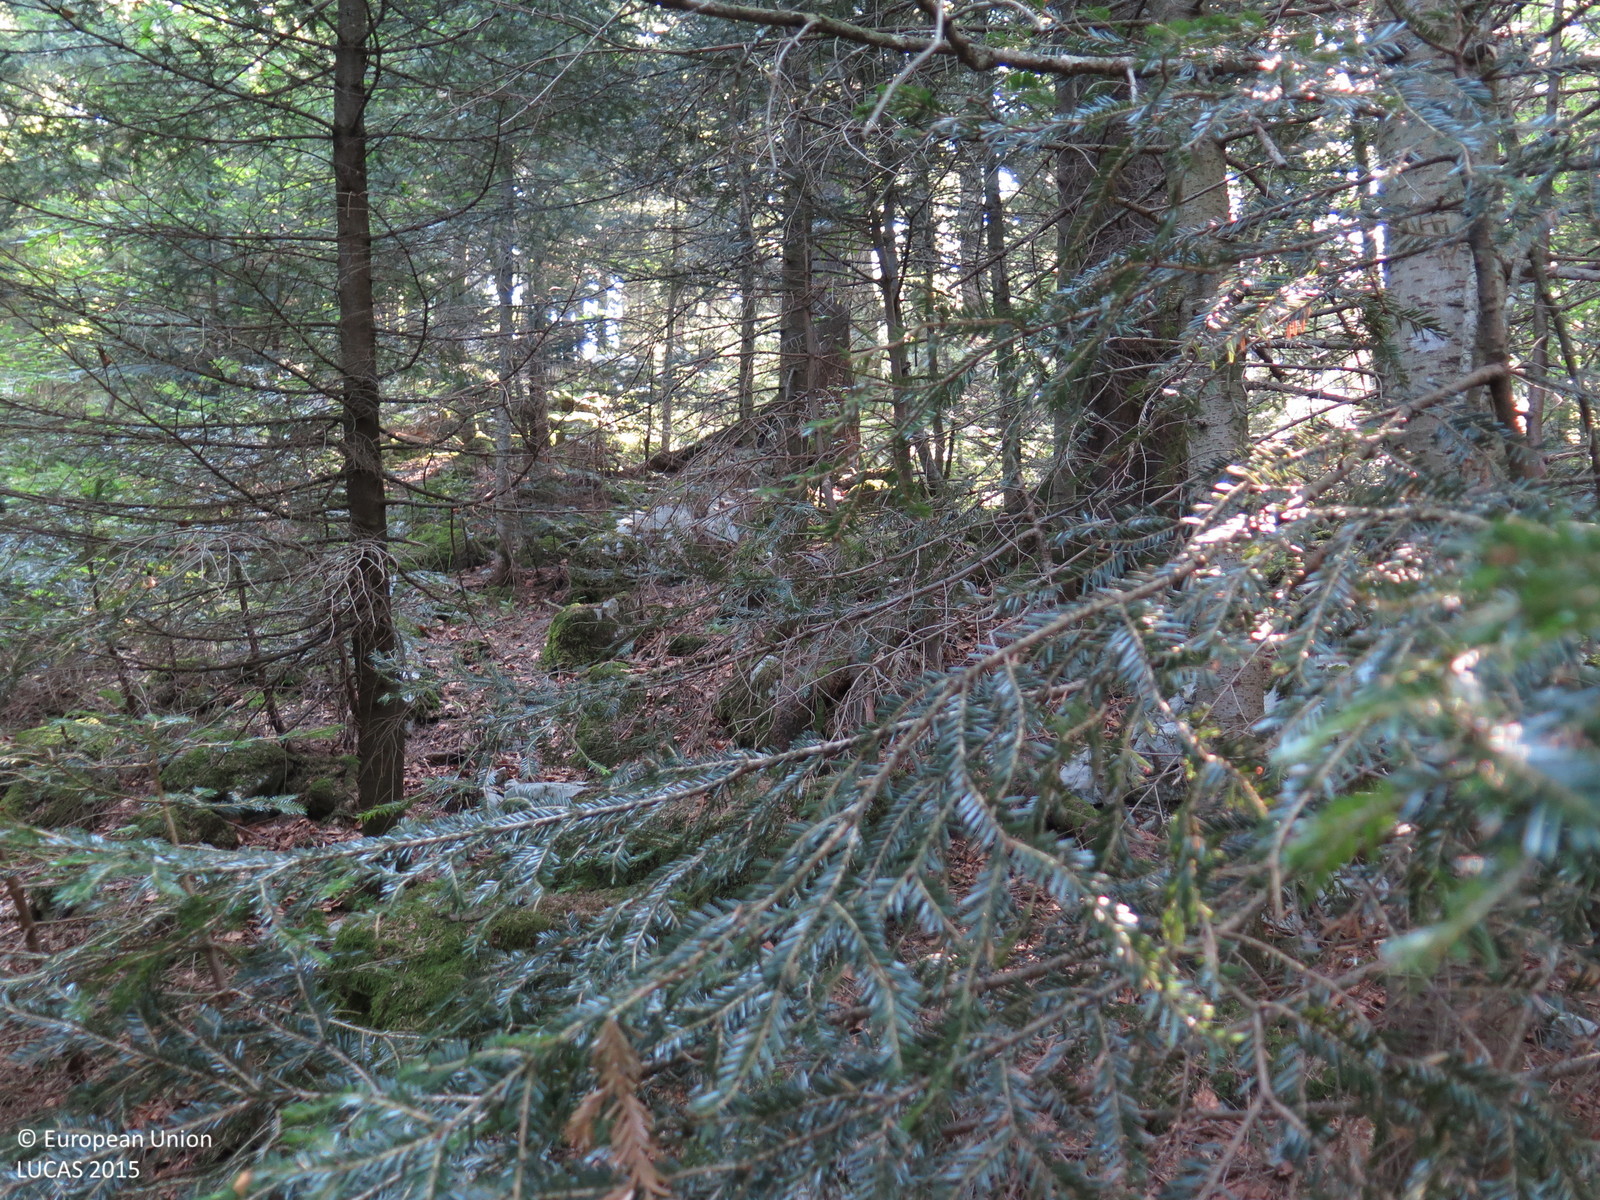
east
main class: Woodland
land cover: Other mixed woodland
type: alpine coniferous forest
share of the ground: > 75 %
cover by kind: coniferous forest trees 75 %, broadleaved forest trees 25 %
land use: Forestry
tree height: > 5 m
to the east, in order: Other mixed woodland
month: August
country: HR
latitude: 45.3517
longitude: 14.9605
